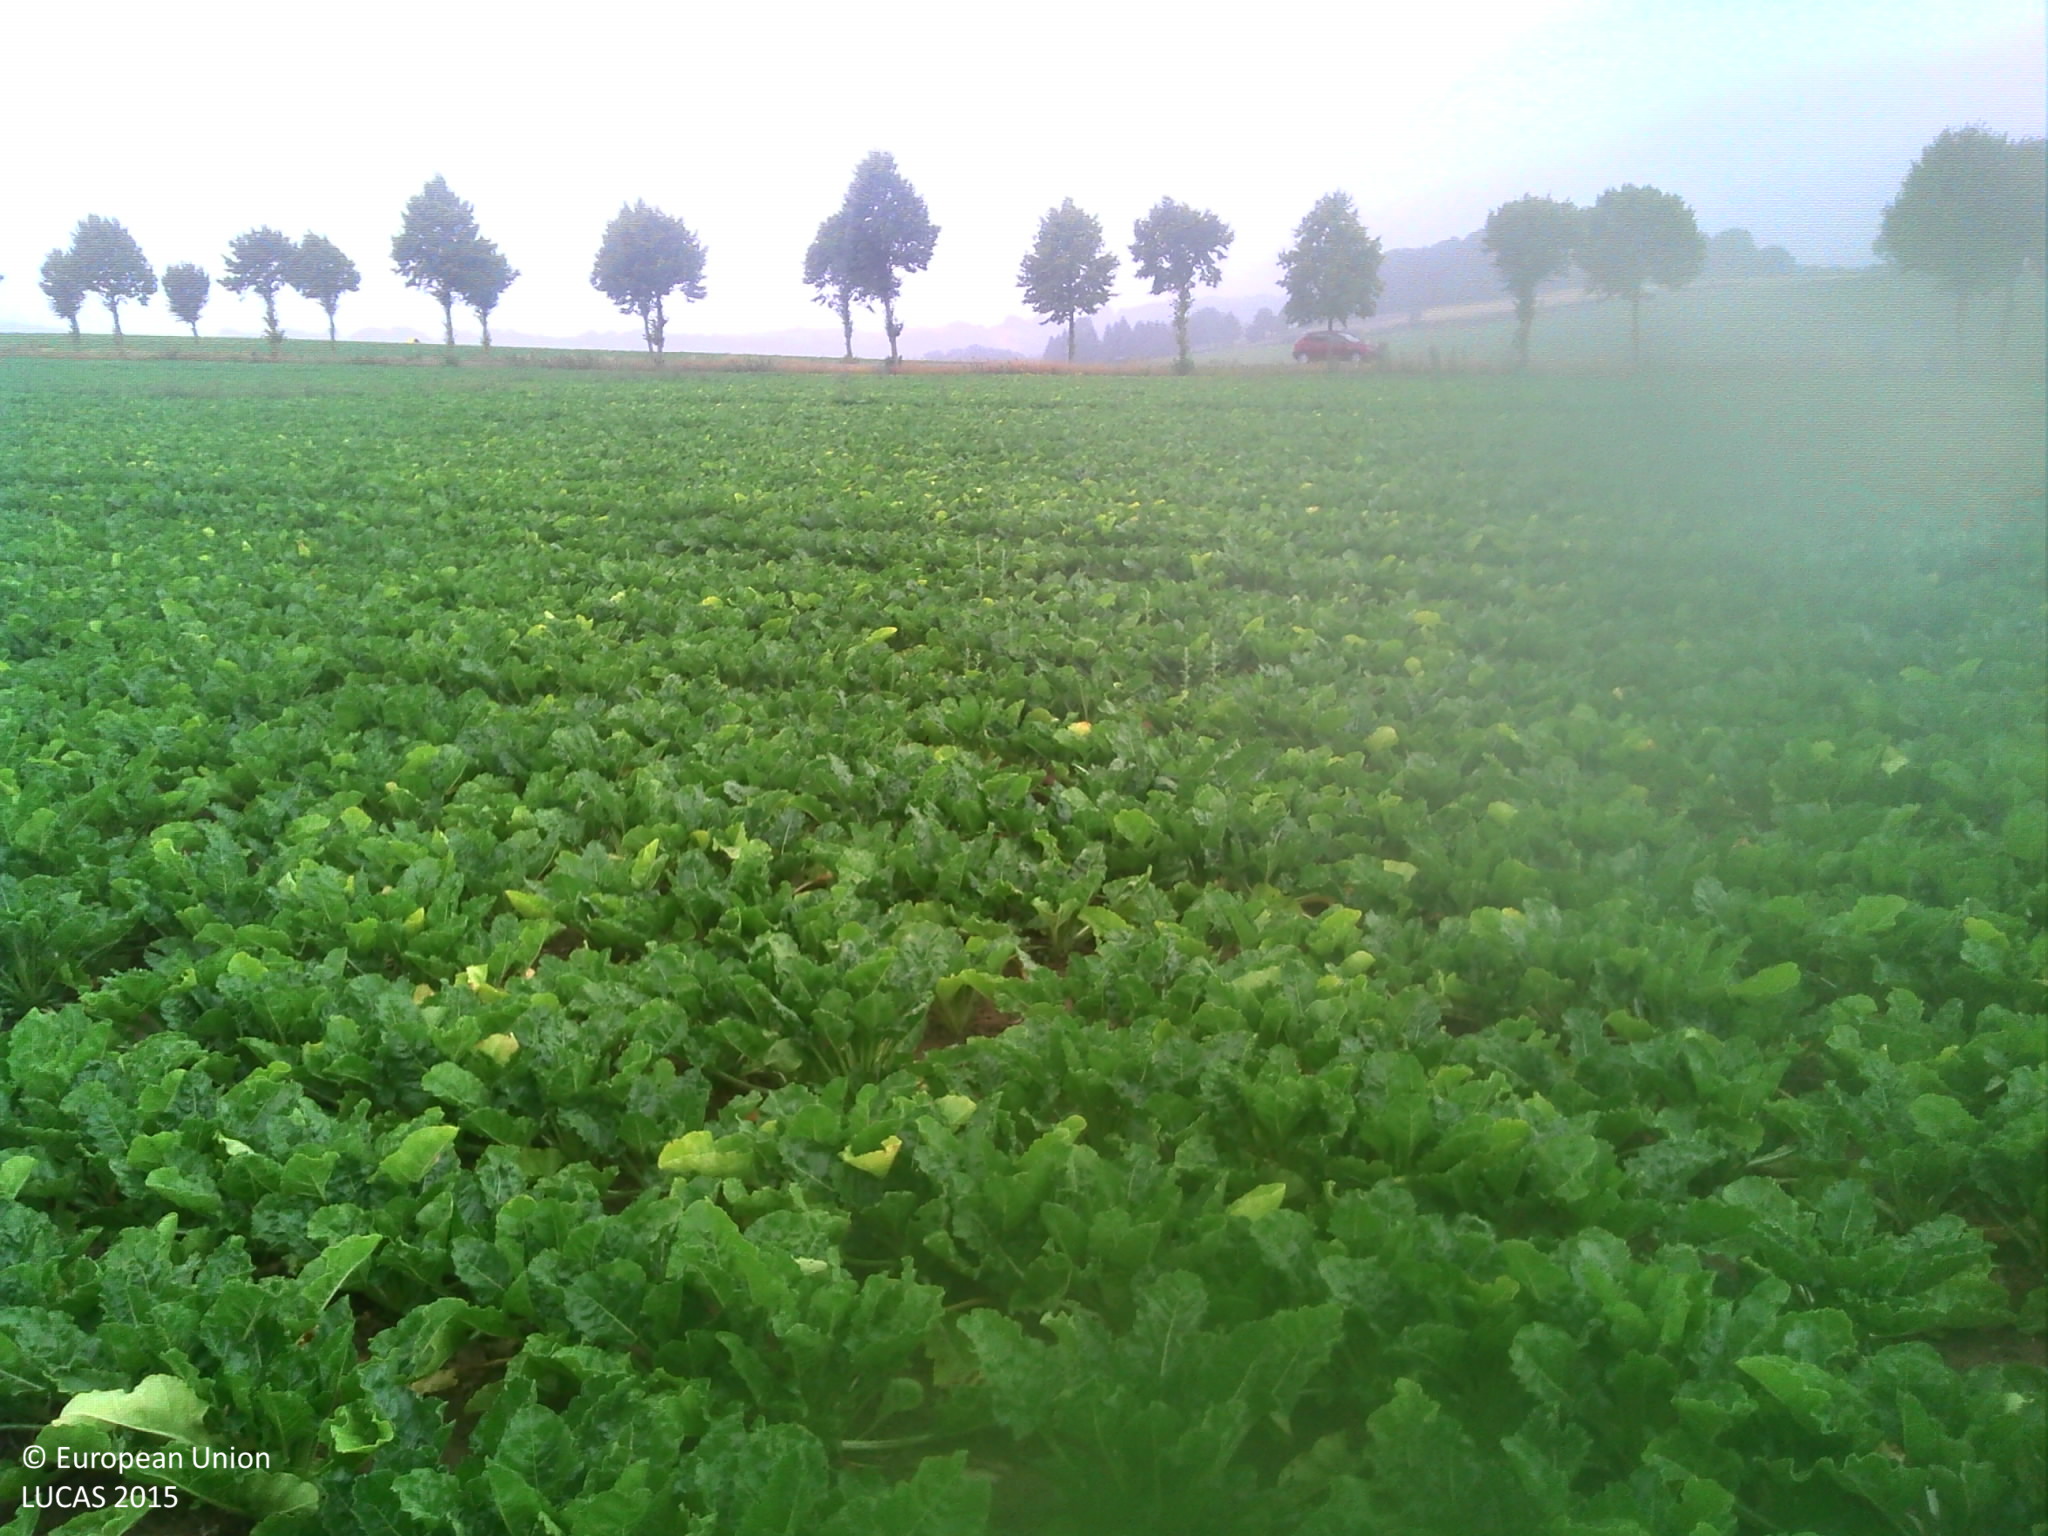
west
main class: Cropland
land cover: Sugar beet
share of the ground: > 75 %
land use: Agriculture (excluding fallow land and kitchen gardens)
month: July
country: FR
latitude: 49.9158
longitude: 3.6285
